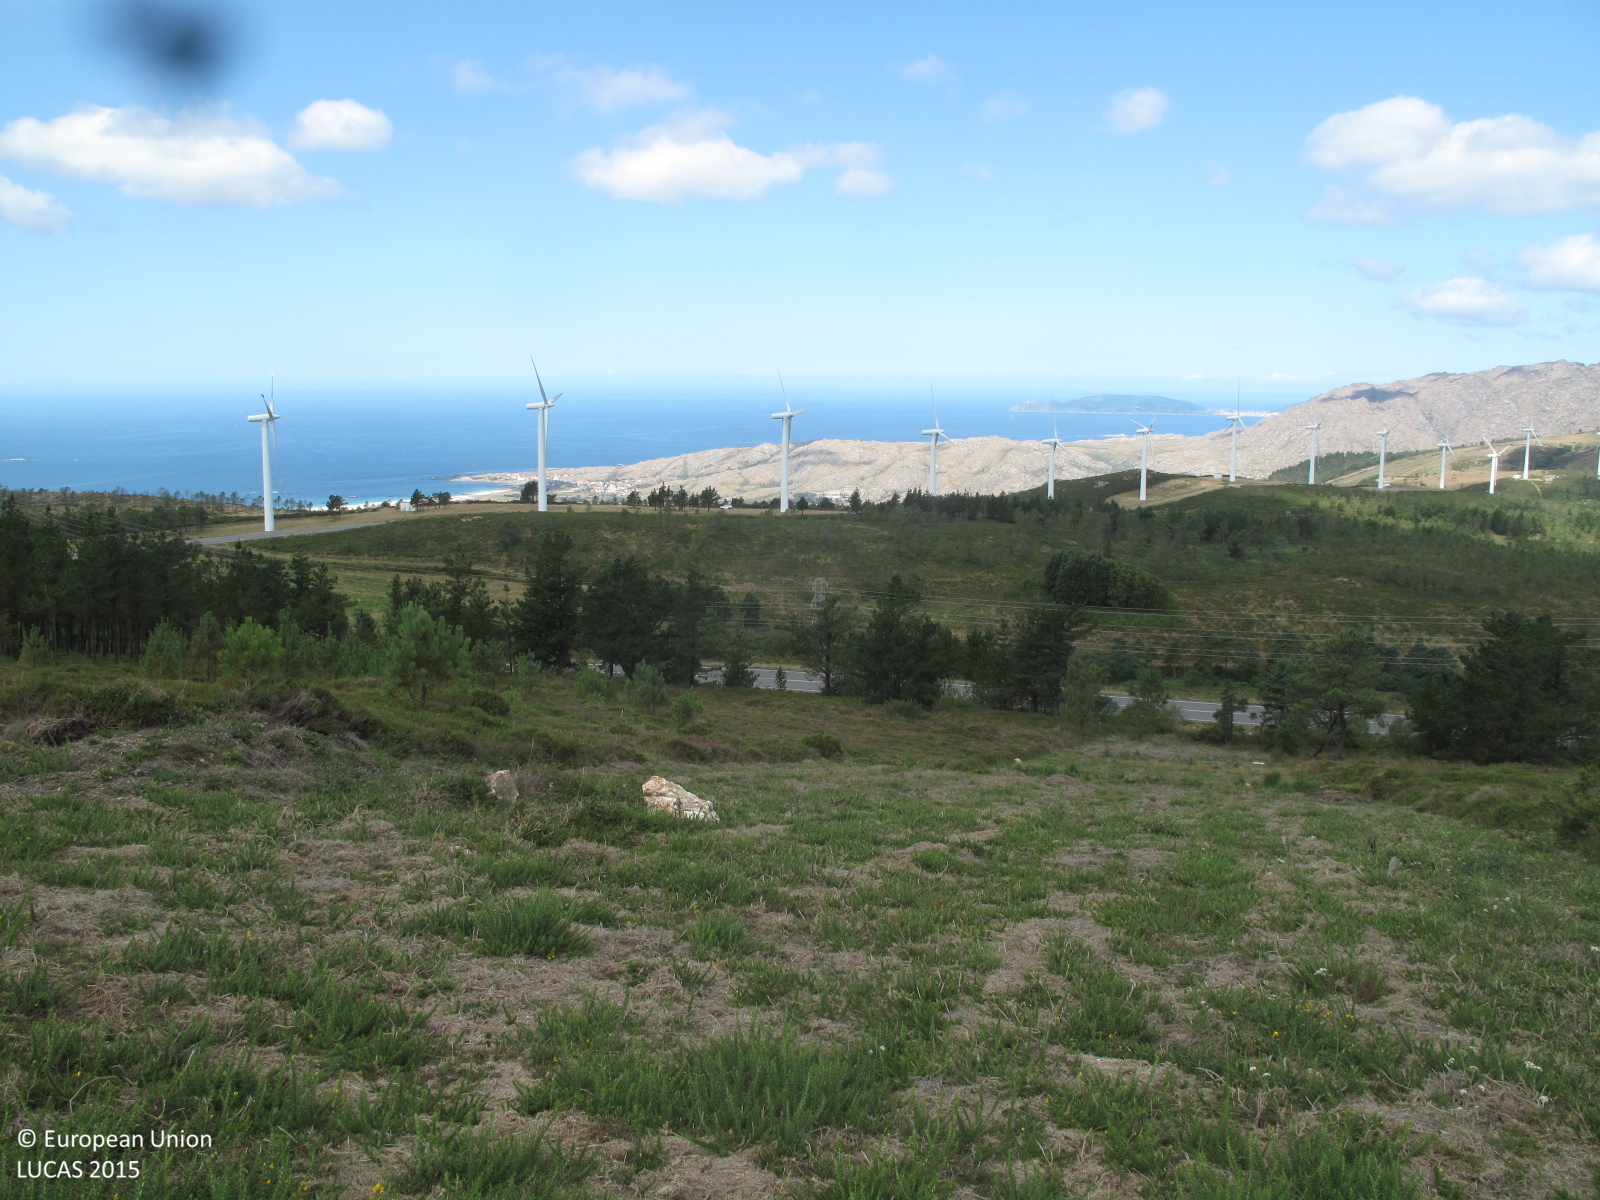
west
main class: Shrubland
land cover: Shrubland with sparse tree cover
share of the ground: > 75 %
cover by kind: shrubs 85 %, herbaceous plants 10 %, coniferous forest trees 5 %
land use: Abandoned areas
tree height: < 5 m
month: July
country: ES
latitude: 42.8604
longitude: -9.0549
